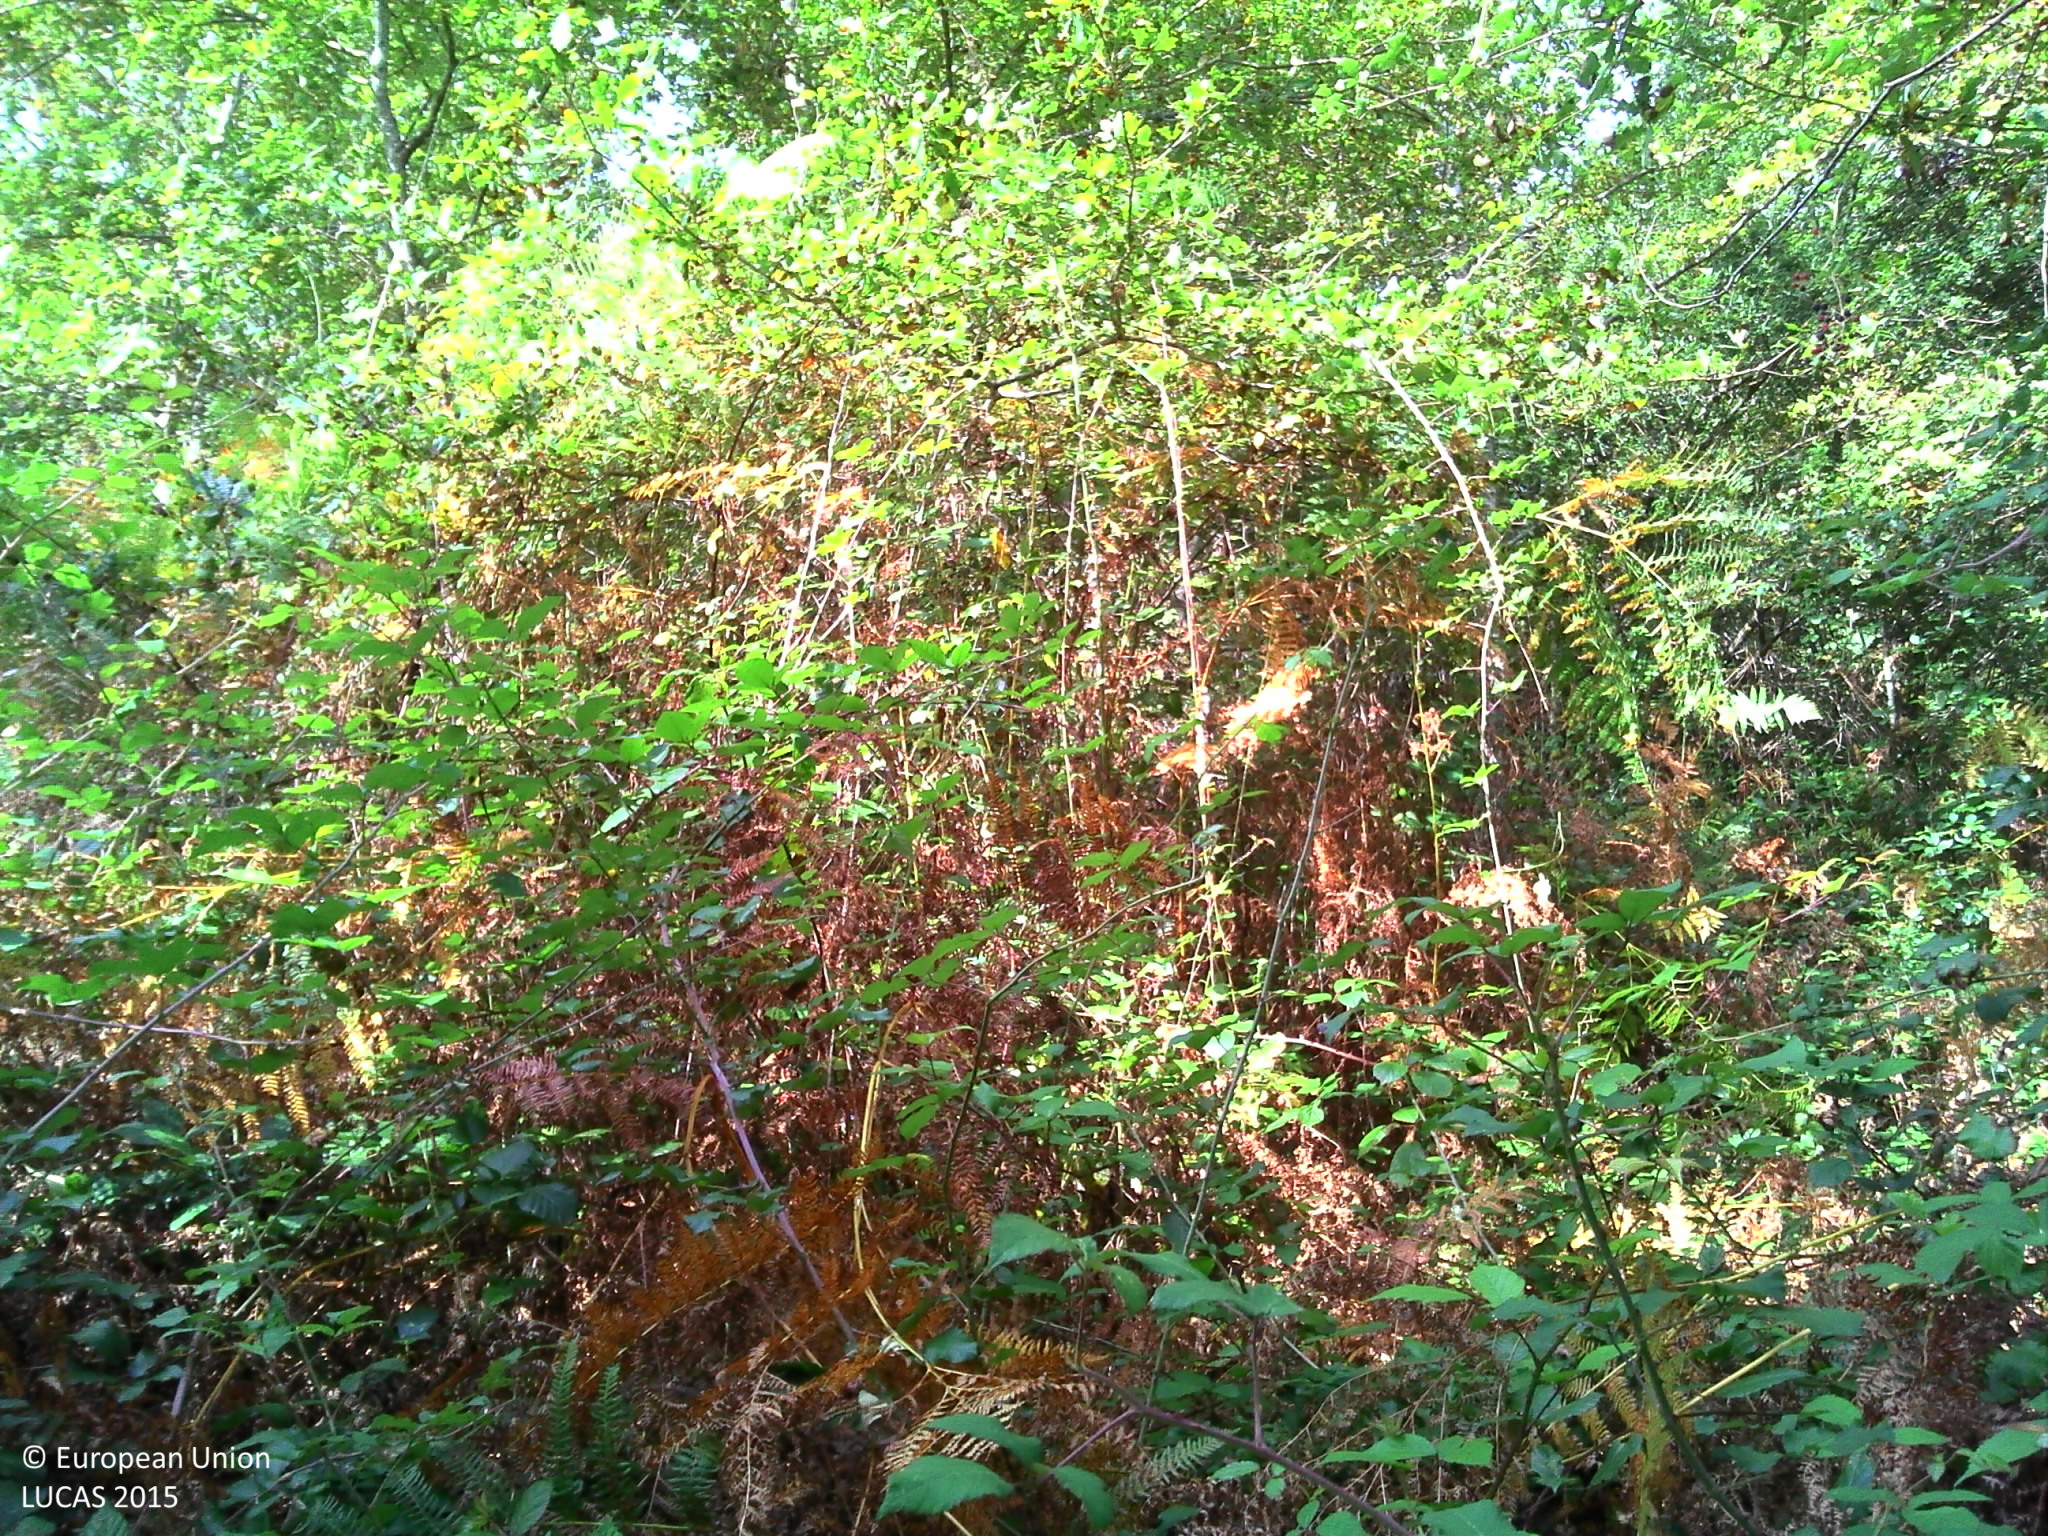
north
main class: Woodland
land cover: Broadleaved woodland
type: acidophilous oak and oak-birch forest
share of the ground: 50 - 75 %
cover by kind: broadleaved forest trees 65 %, shrubs 30 %, herbaceous plants 5 %
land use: Forestry
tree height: > 5 m
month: September
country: FR
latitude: 43.2003
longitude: -0.4800
